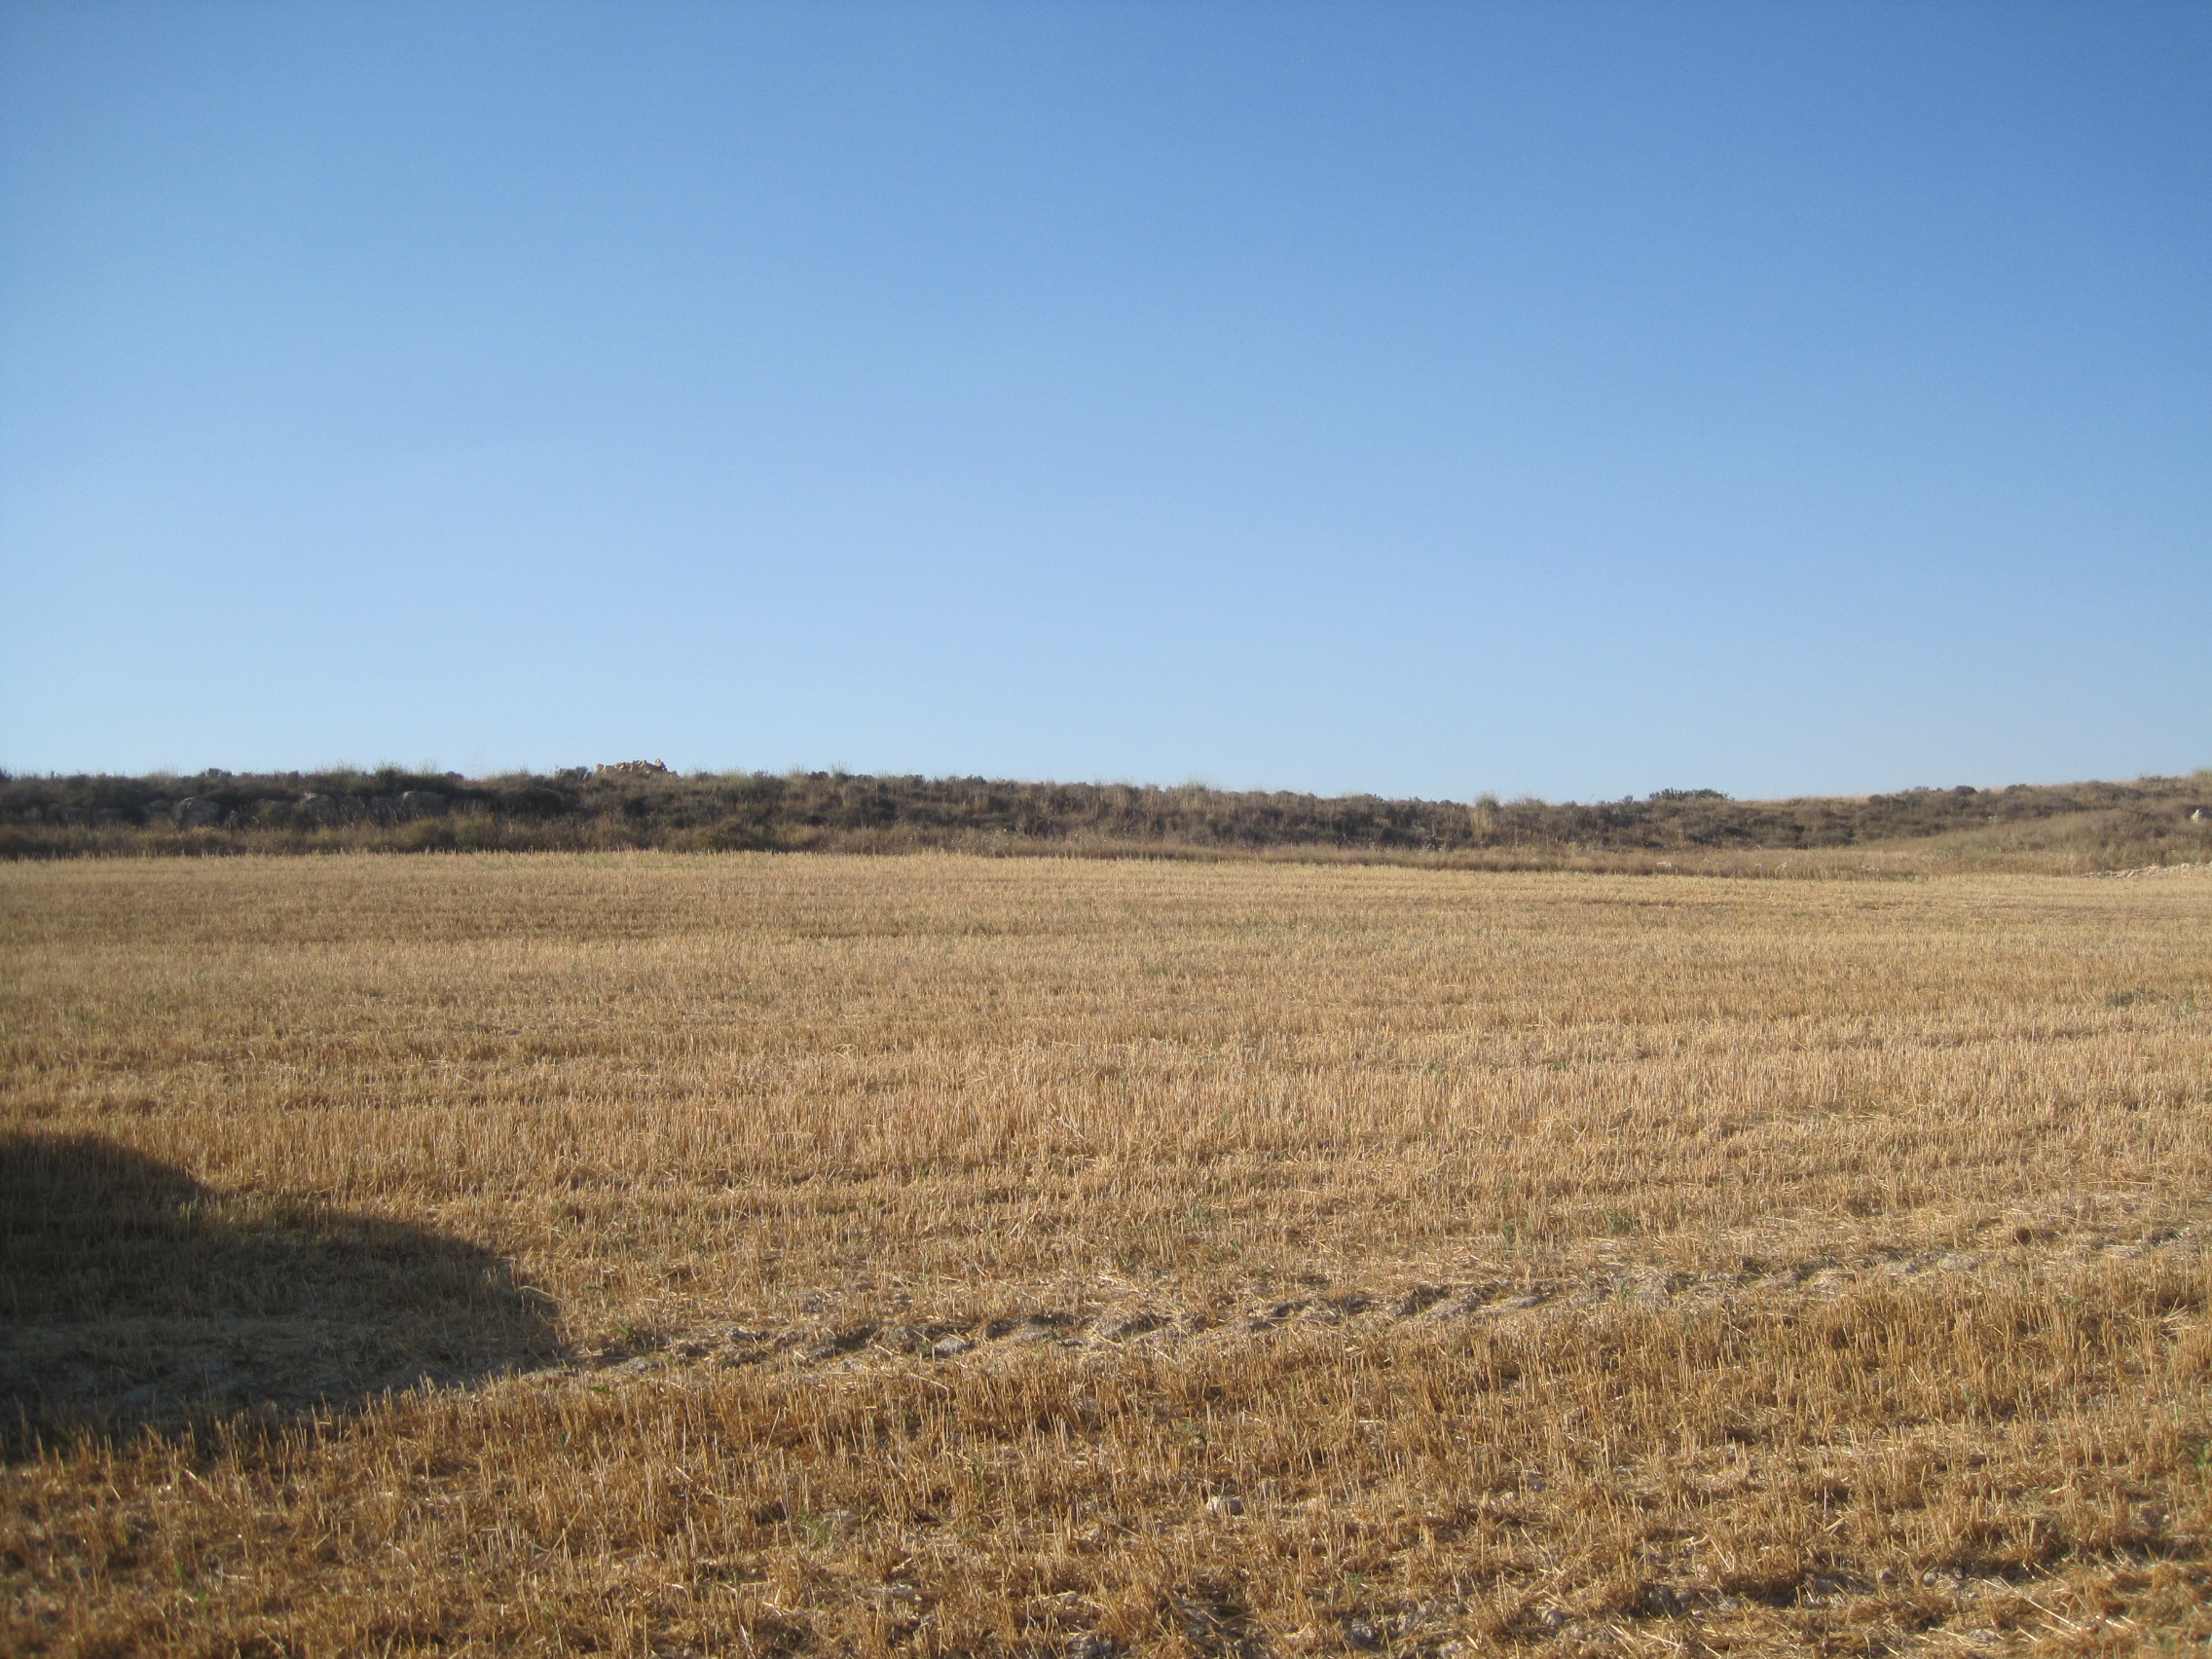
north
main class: Cropland
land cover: Barley
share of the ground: < 10 %
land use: Agriculture (excluding fallow land and kitchen gardens)
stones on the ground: 10 - 25 %
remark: Harvested field
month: July
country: ES
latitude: 41.6753
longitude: -5.1276
